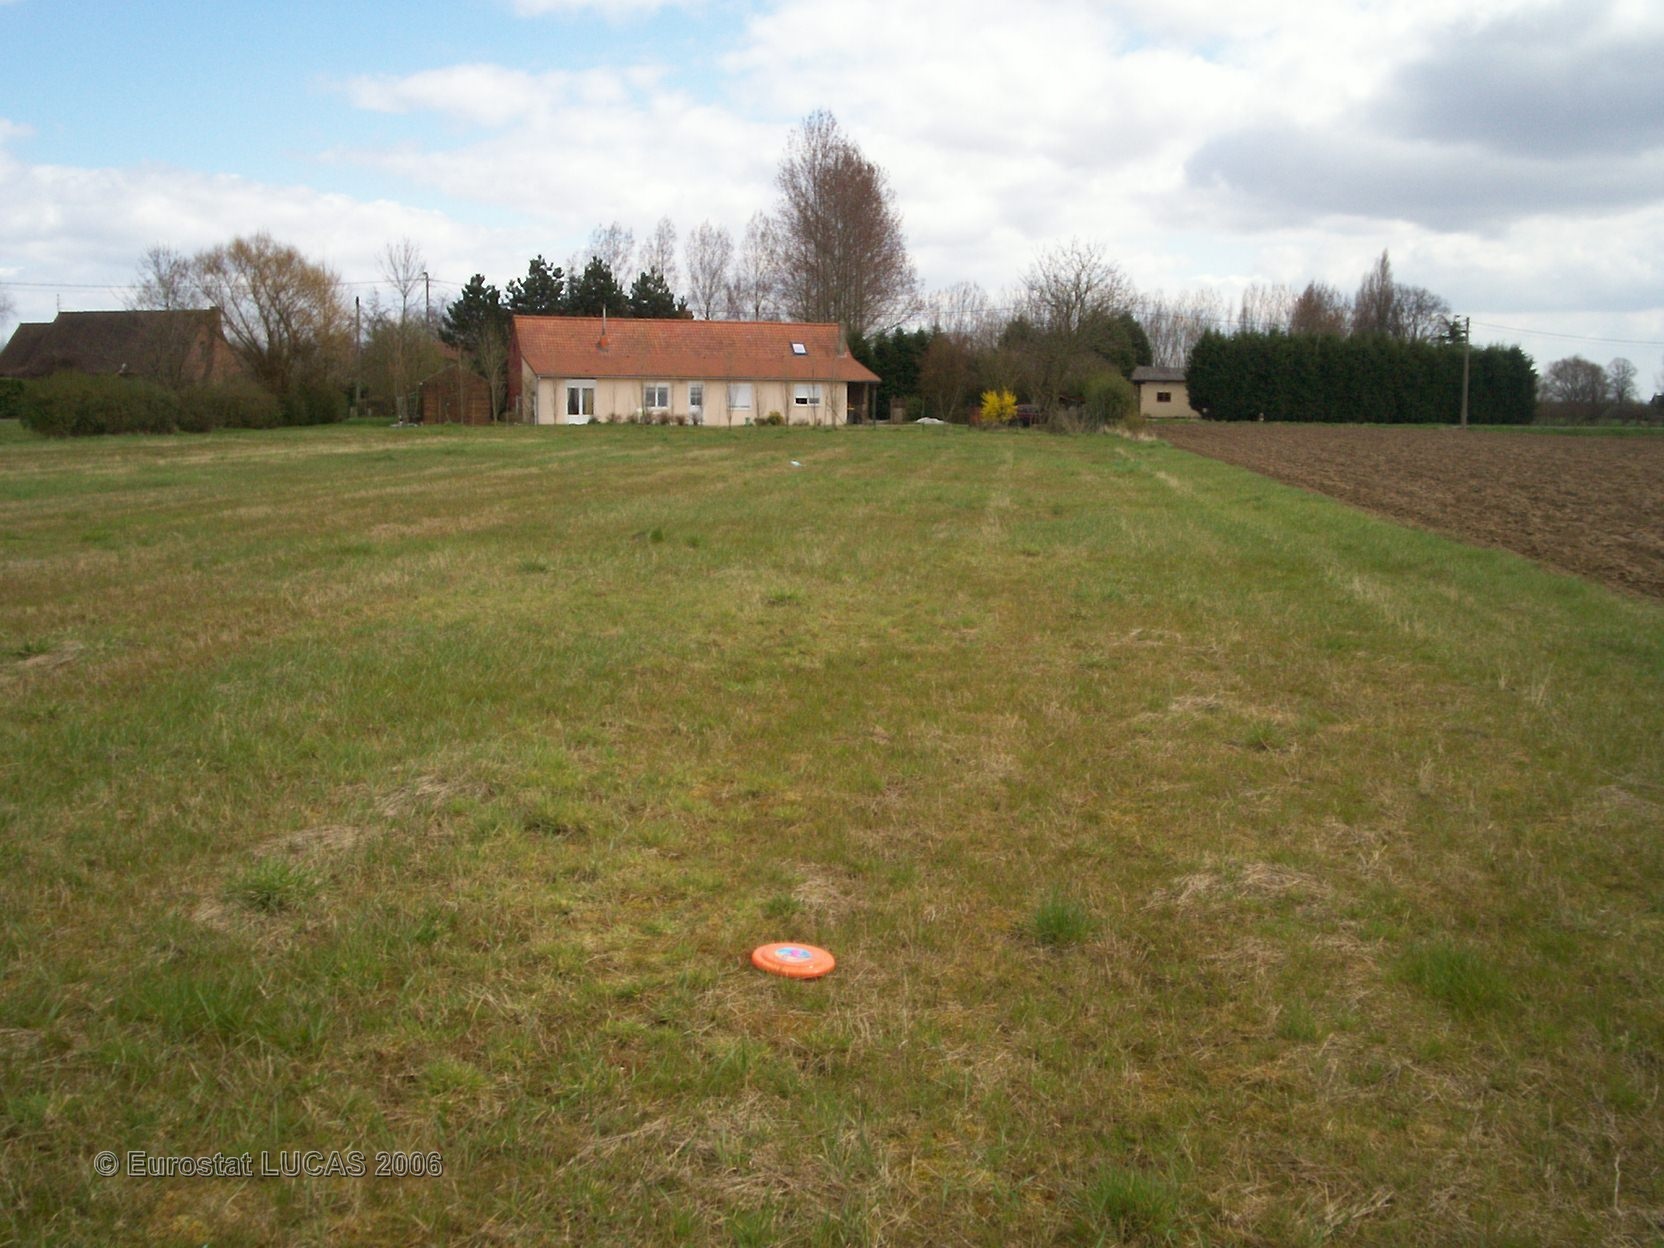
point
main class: Grassland
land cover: Grassland without tree/shrub cover
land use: Agriculture (excluding fallow land and kitchen gardens)
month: April
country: FR
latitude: 50.6116
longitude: 2.5970
